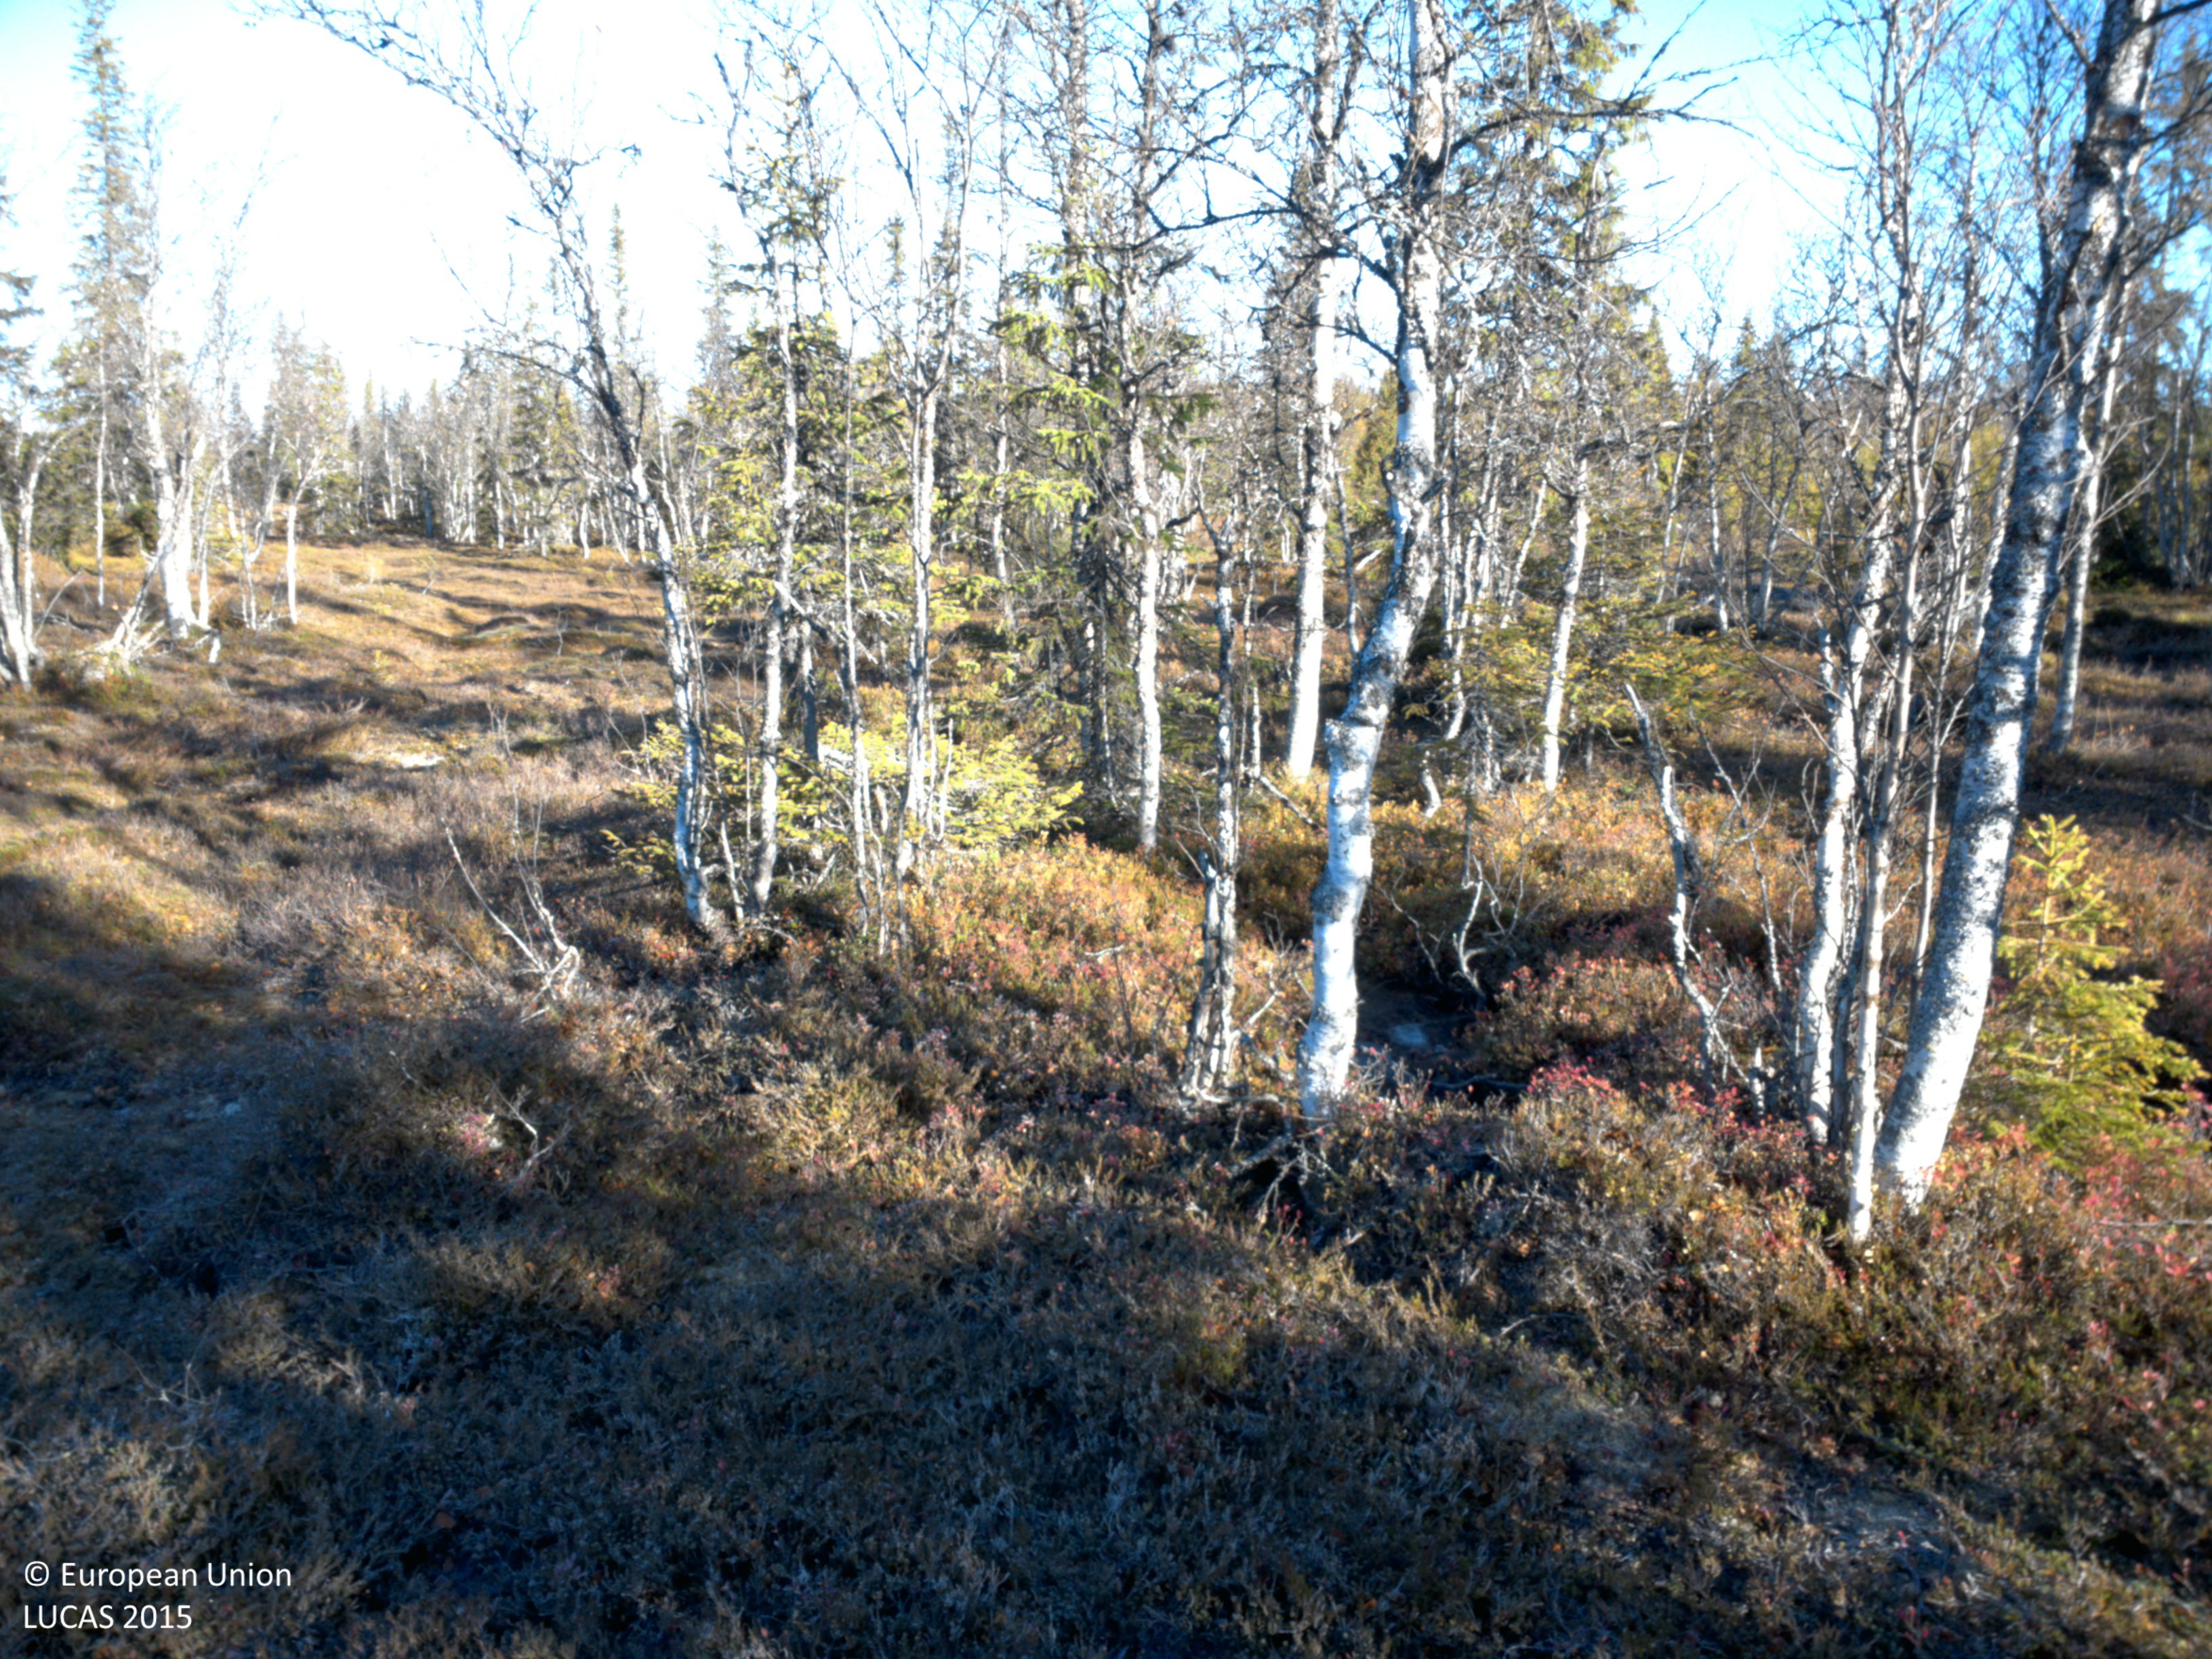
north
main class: Woodland
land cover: Spruce dominated mixed woodland
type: boreal forest
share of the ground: 25 - 50 %
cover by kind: shrubs 35 %, herbaceous plants 30 %, coniferous forest trees 15 %, broadleaved forest trees 15 %, lichens and mosses 5 %
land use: Forestry
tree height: < 5 m
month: October
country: SE
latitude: 64.5917
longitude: 17.7162
